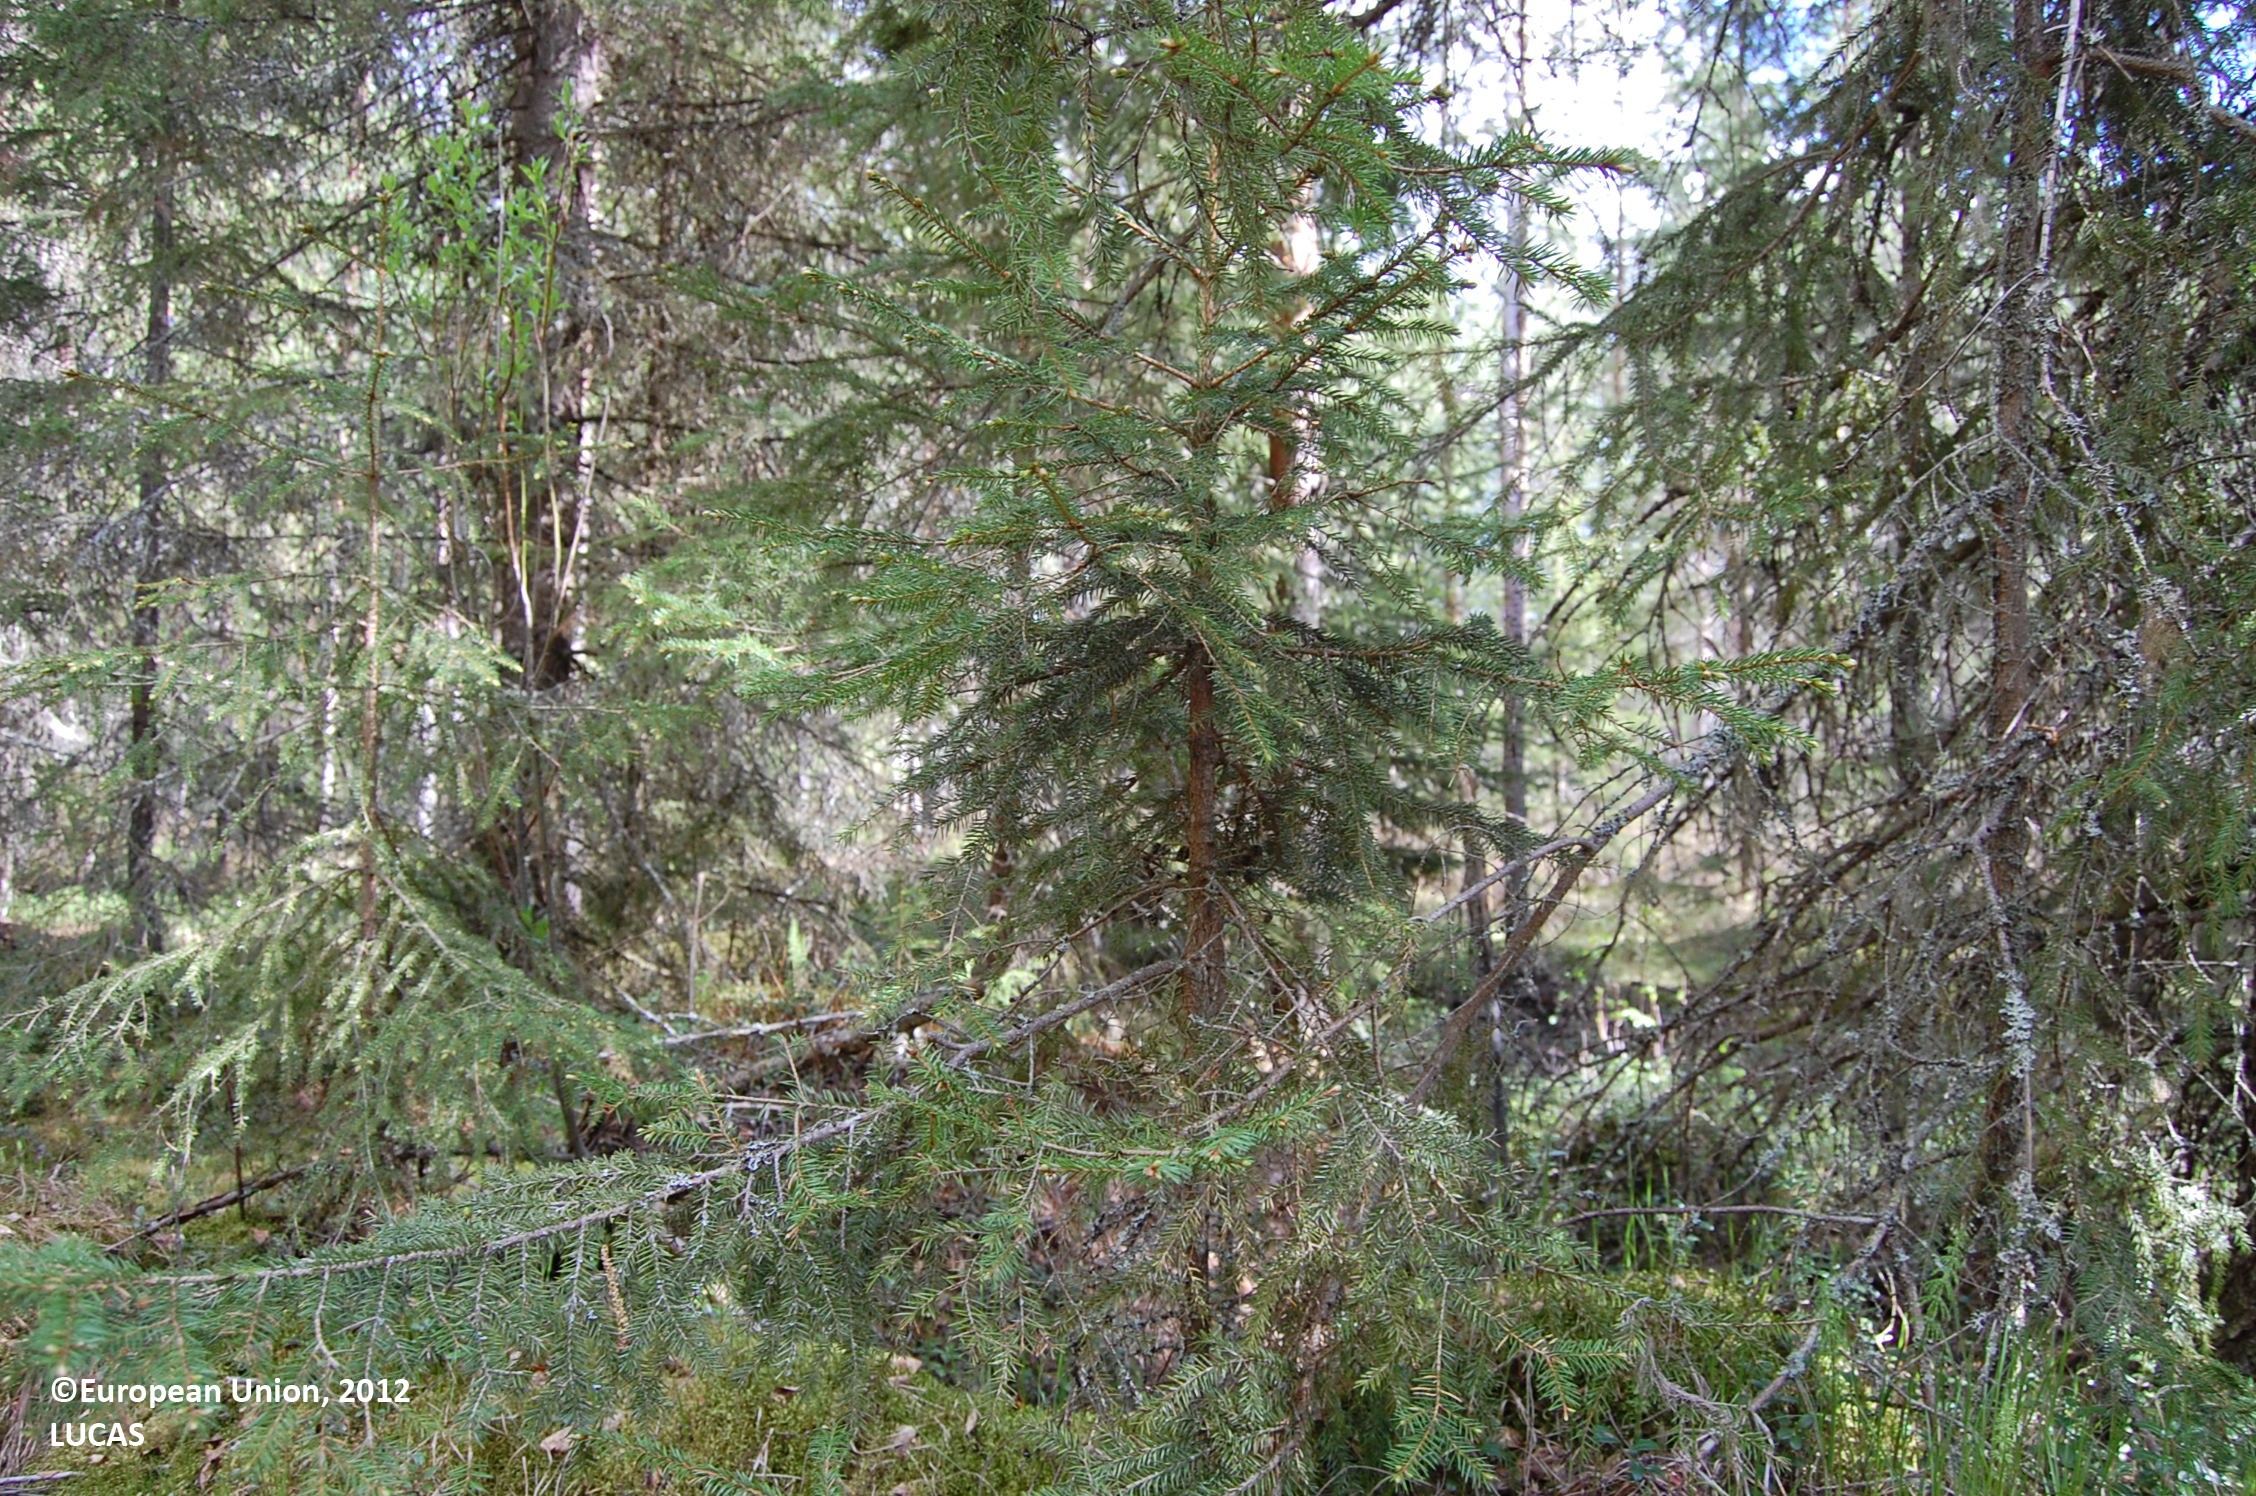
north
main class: Woodland
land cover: Other mixed woodland
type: boreal forest
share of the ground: > 75 %
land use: Forestry
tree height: > 5 m
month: May
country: FI
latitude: 64.2933
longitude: 26.2480
